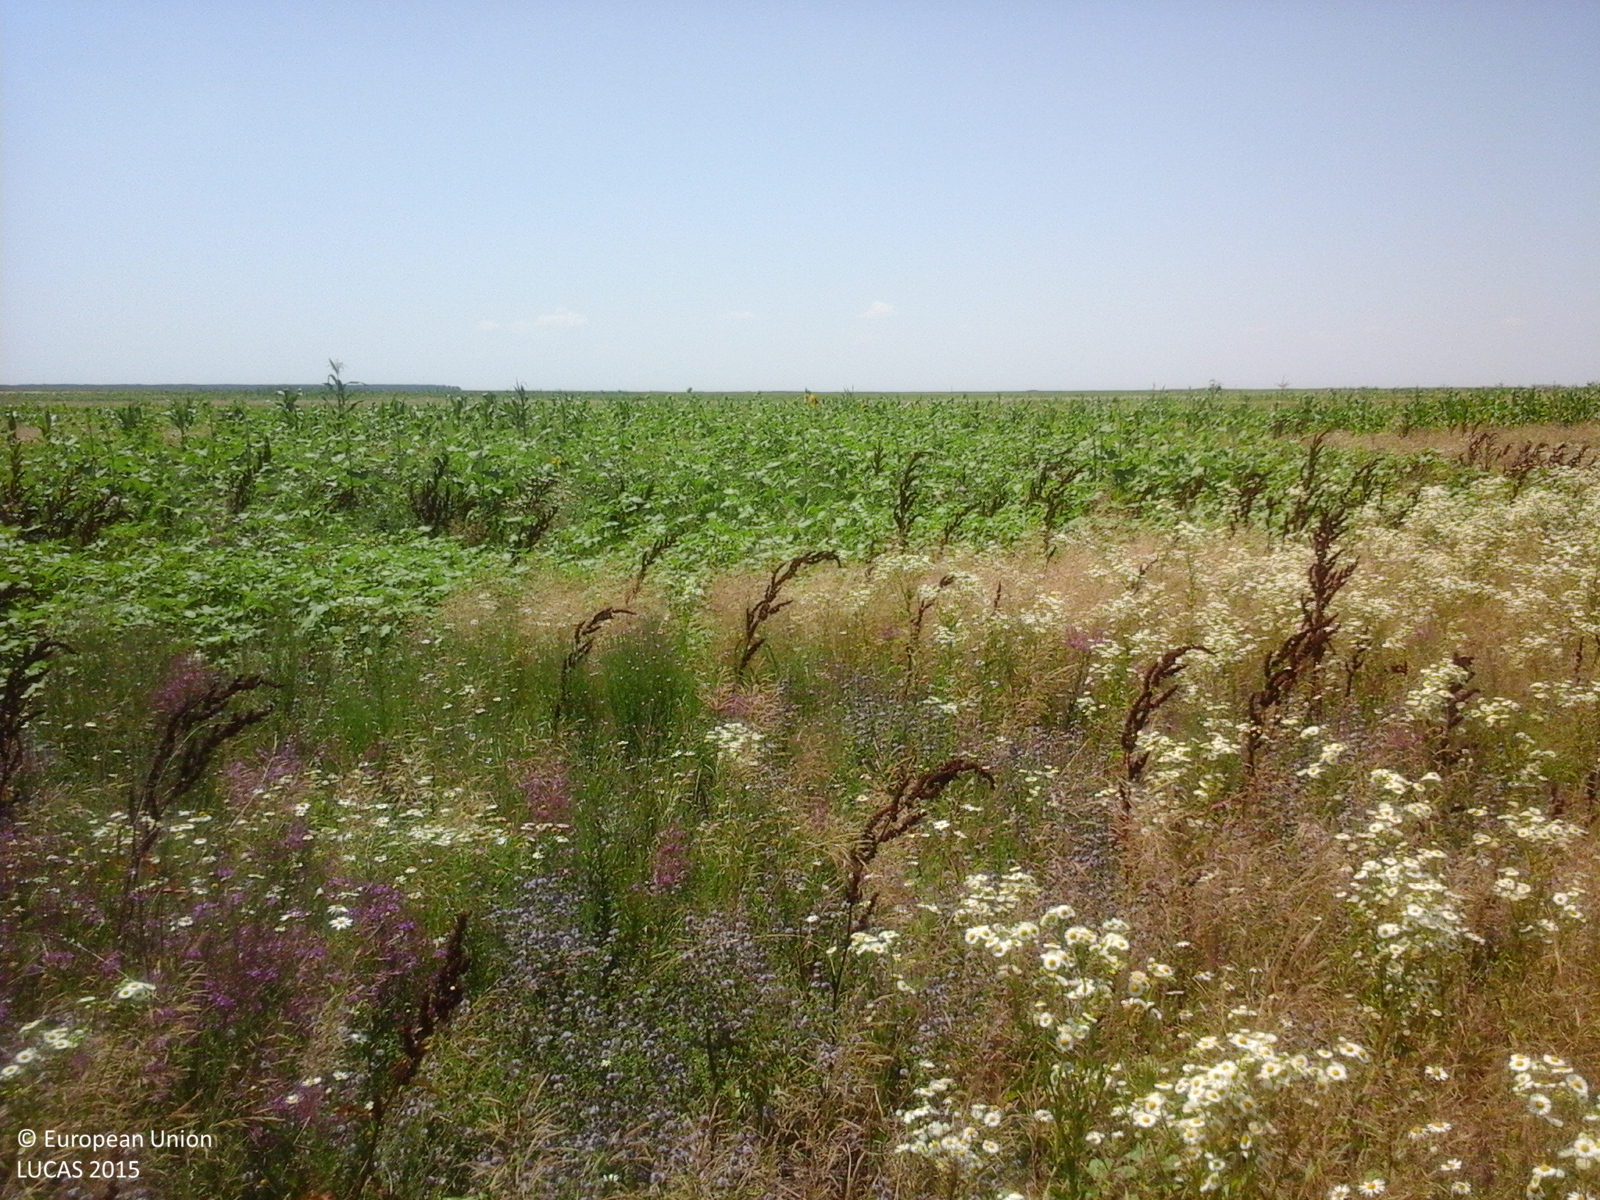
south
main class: Grassland
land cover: Spontaneously vegetated surfaces
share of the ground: > 75 %
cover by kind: herbaceous plants 100 %
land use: Fallow land
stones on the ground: 10 - 25 %
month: July
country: RO
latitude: 44.2330
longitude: 24.5553
